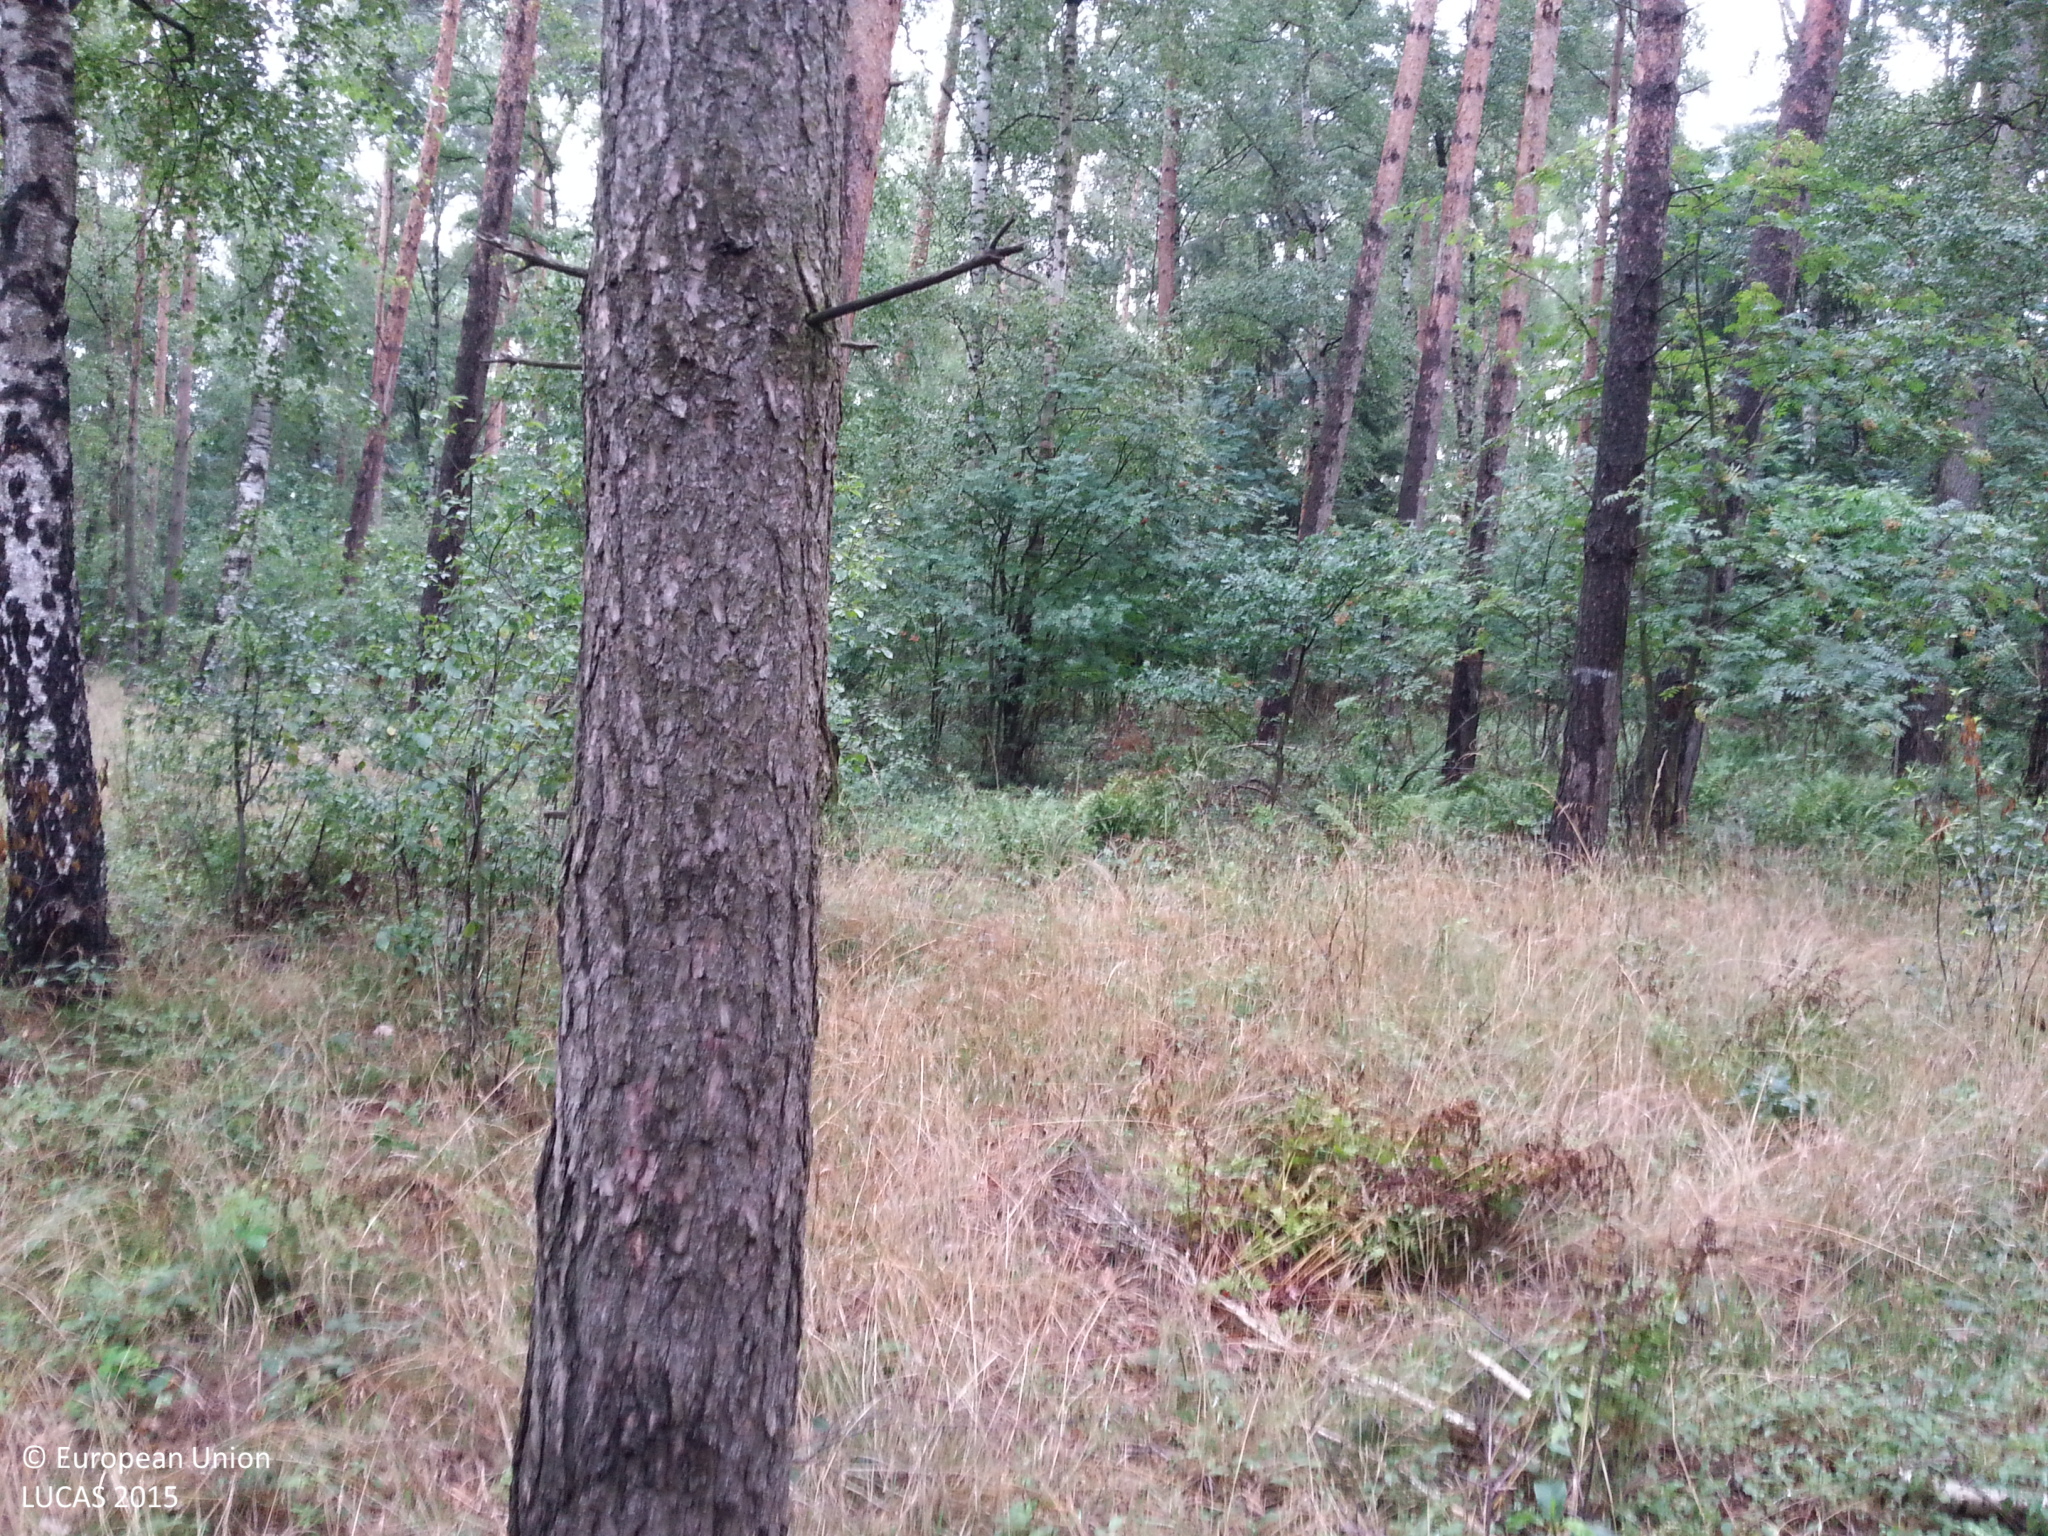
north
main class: Woodland
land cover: Pine dominated mixed woodland
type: hemiboreal forest and nemoral coniferous forest and mixed broadleaved-coniferous forest
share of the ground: 50 - 75 %
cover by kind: coniferous forest trees 40 %, broadleaved forest trees 20 %, herbaceous plants 20 %, shrubs 10 %, lichens and mosses 10 %
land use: Forestry
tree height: > 5 m
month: July
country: DE
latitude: 53.0190
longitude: 11.1474
